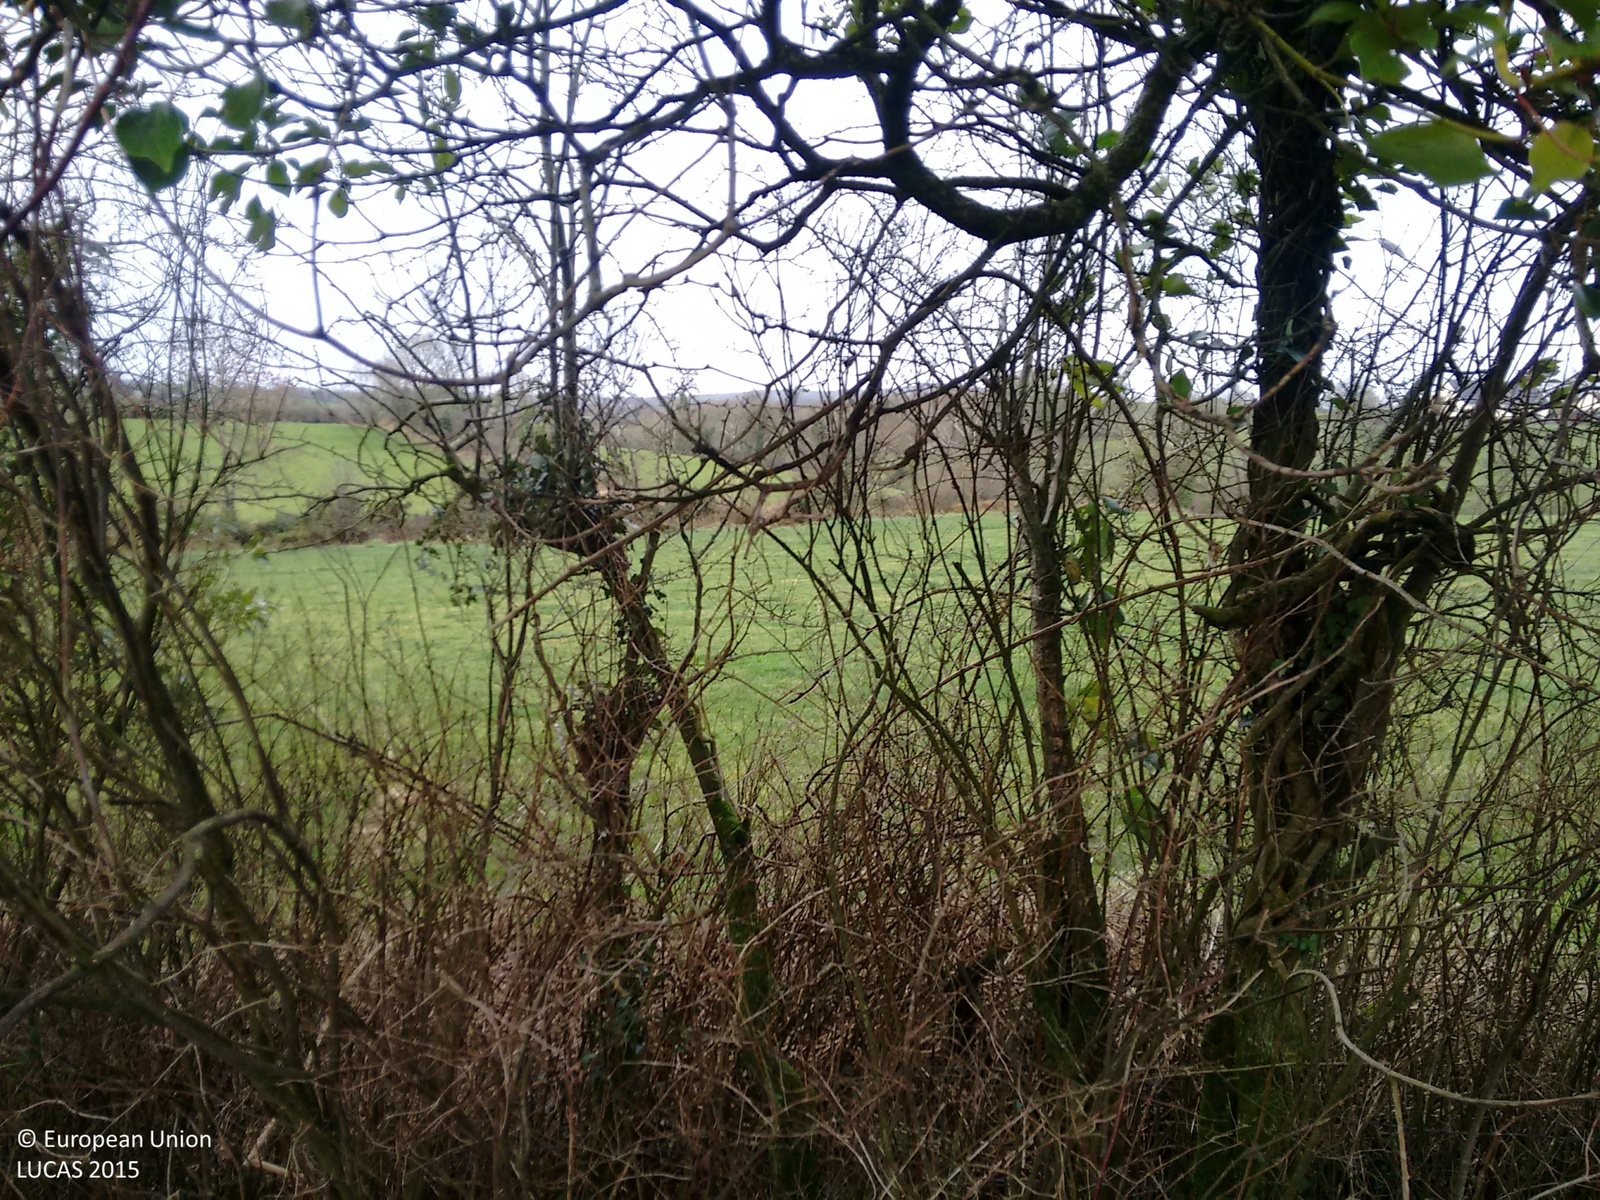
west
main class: Grassland
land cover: Grassland without tree/shrub cover
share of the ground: > 75 %
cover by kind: herbaceous plants 100 %
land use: Agriculture (excluding fallow land and kitchen gardens)
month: December
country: IE
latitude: 54.0139
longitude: -7.2248
